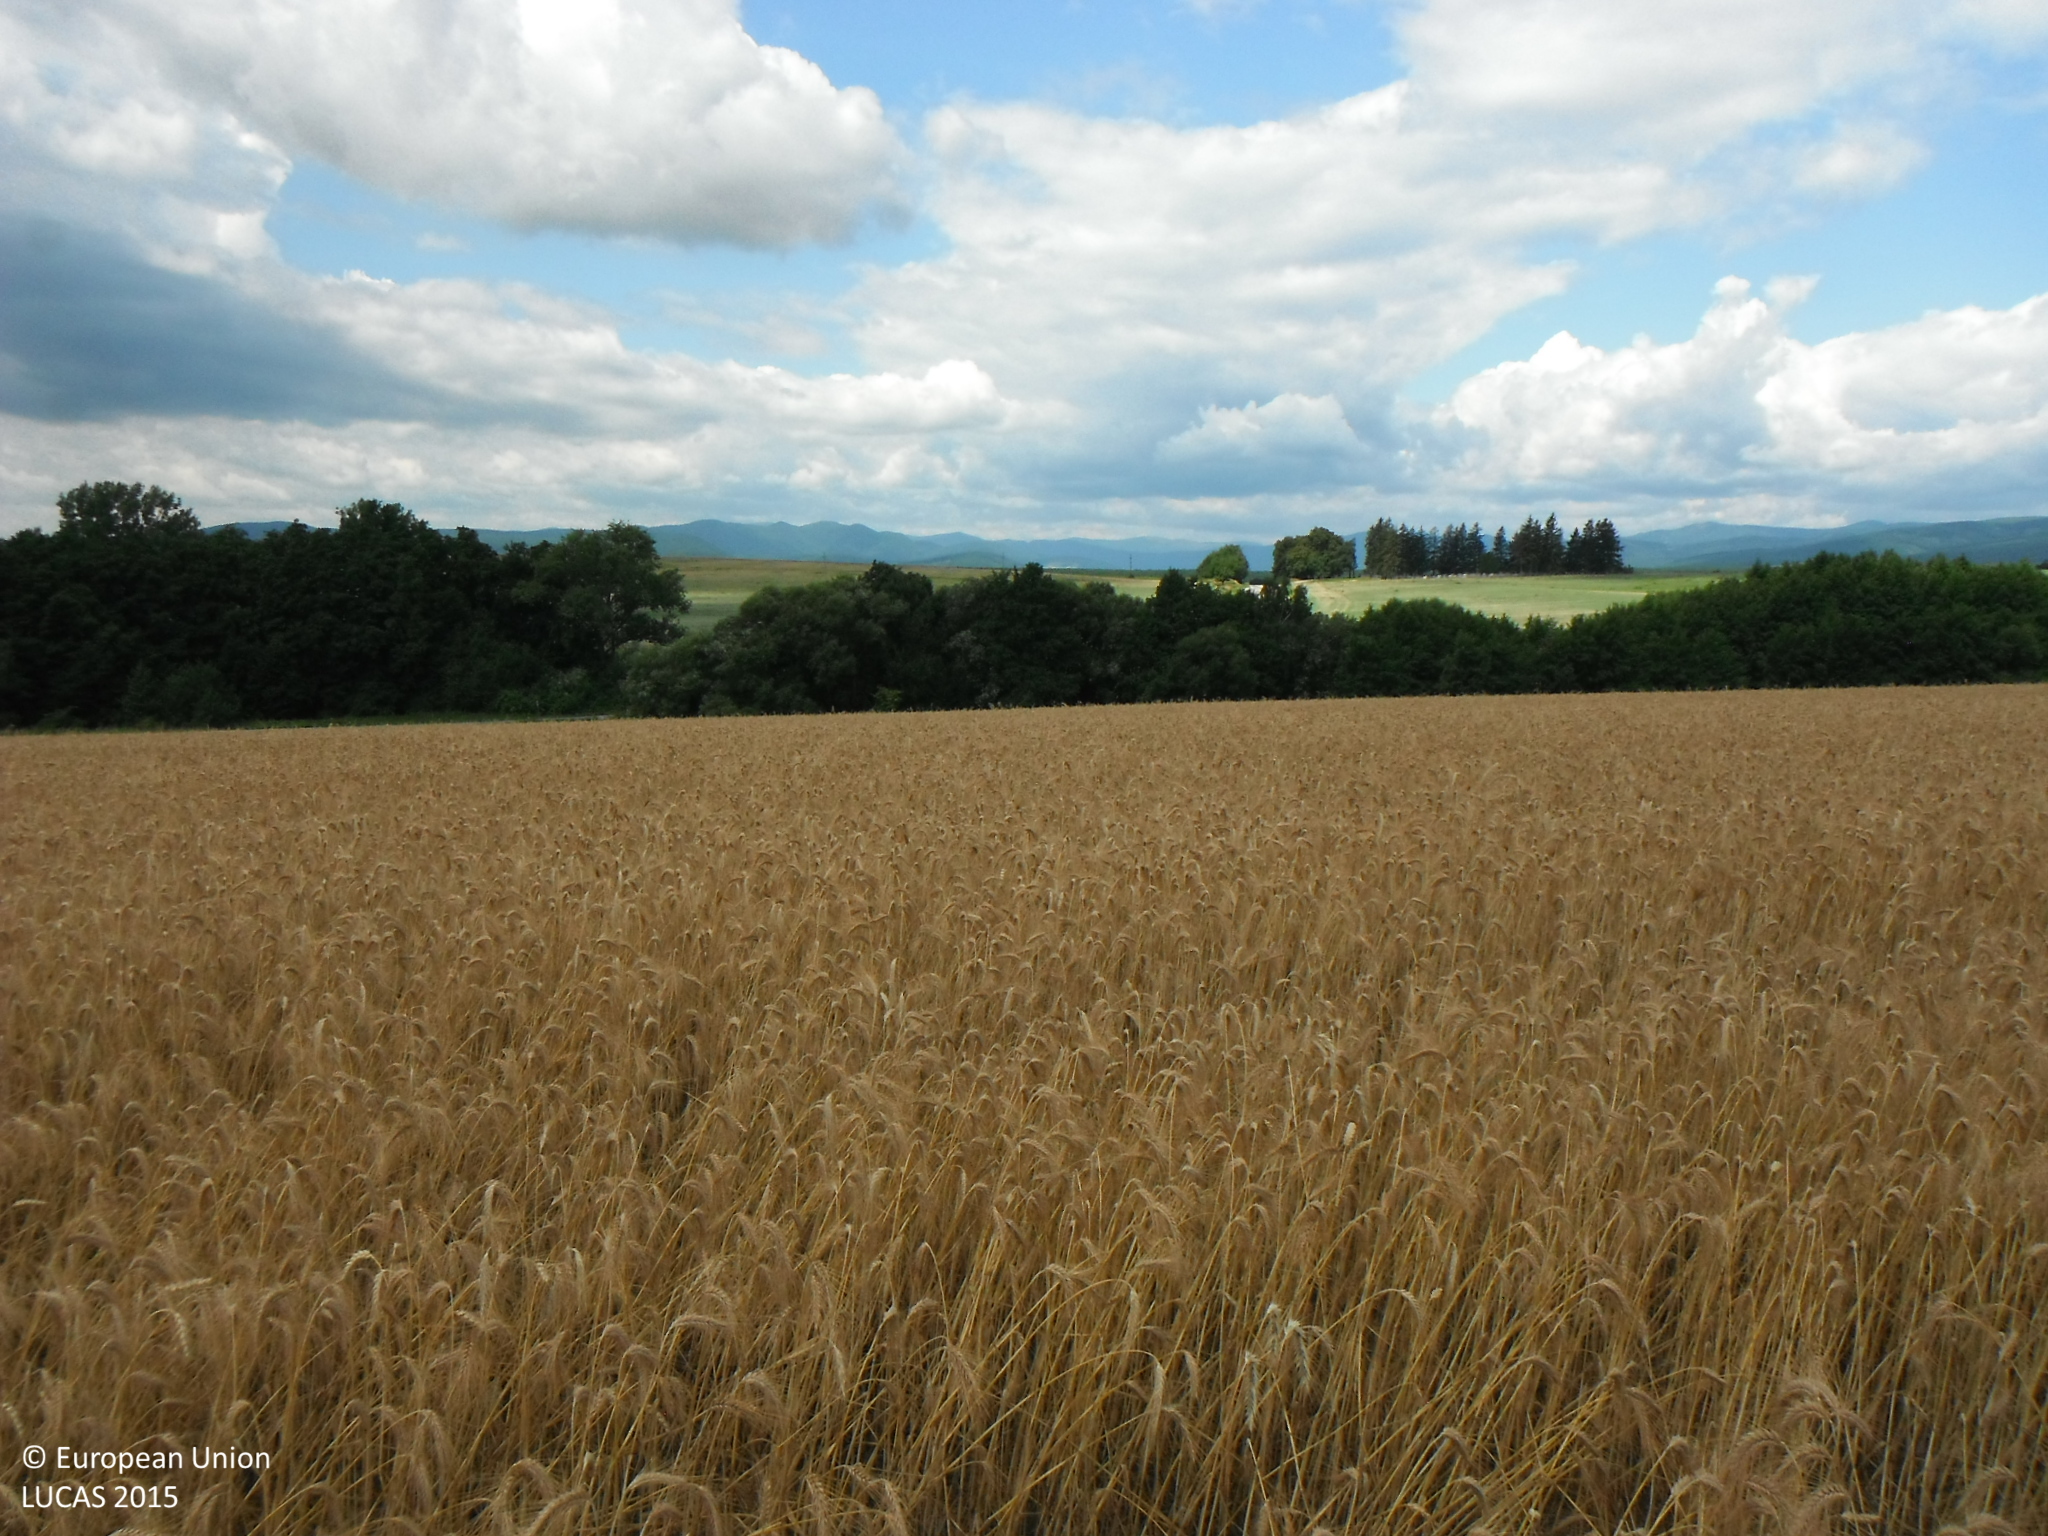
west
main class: Cropland
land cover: Triticale
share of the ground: > 75 %
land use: Agriculture (excluding fallow land and kitchen gardens)
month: July
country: SK
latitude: 48.6797
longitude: 21.0842
